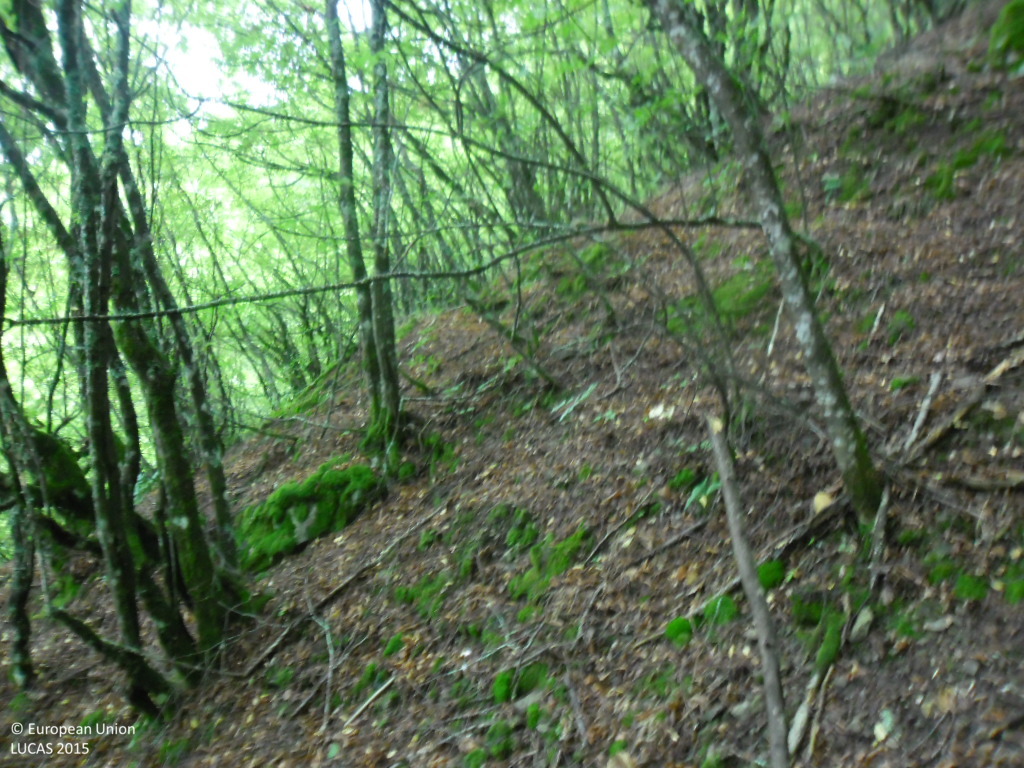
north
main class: Woodland
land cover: Broadleaved woodland
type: mesophytic deciduous forest
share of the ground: > 75 %
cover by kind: broadleaved forest trees 90 %, unconsolidated bare surface 10 %
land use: Forestry
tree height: > 5 m
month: September
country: BG
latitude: 41.3574
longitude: 22.9851
